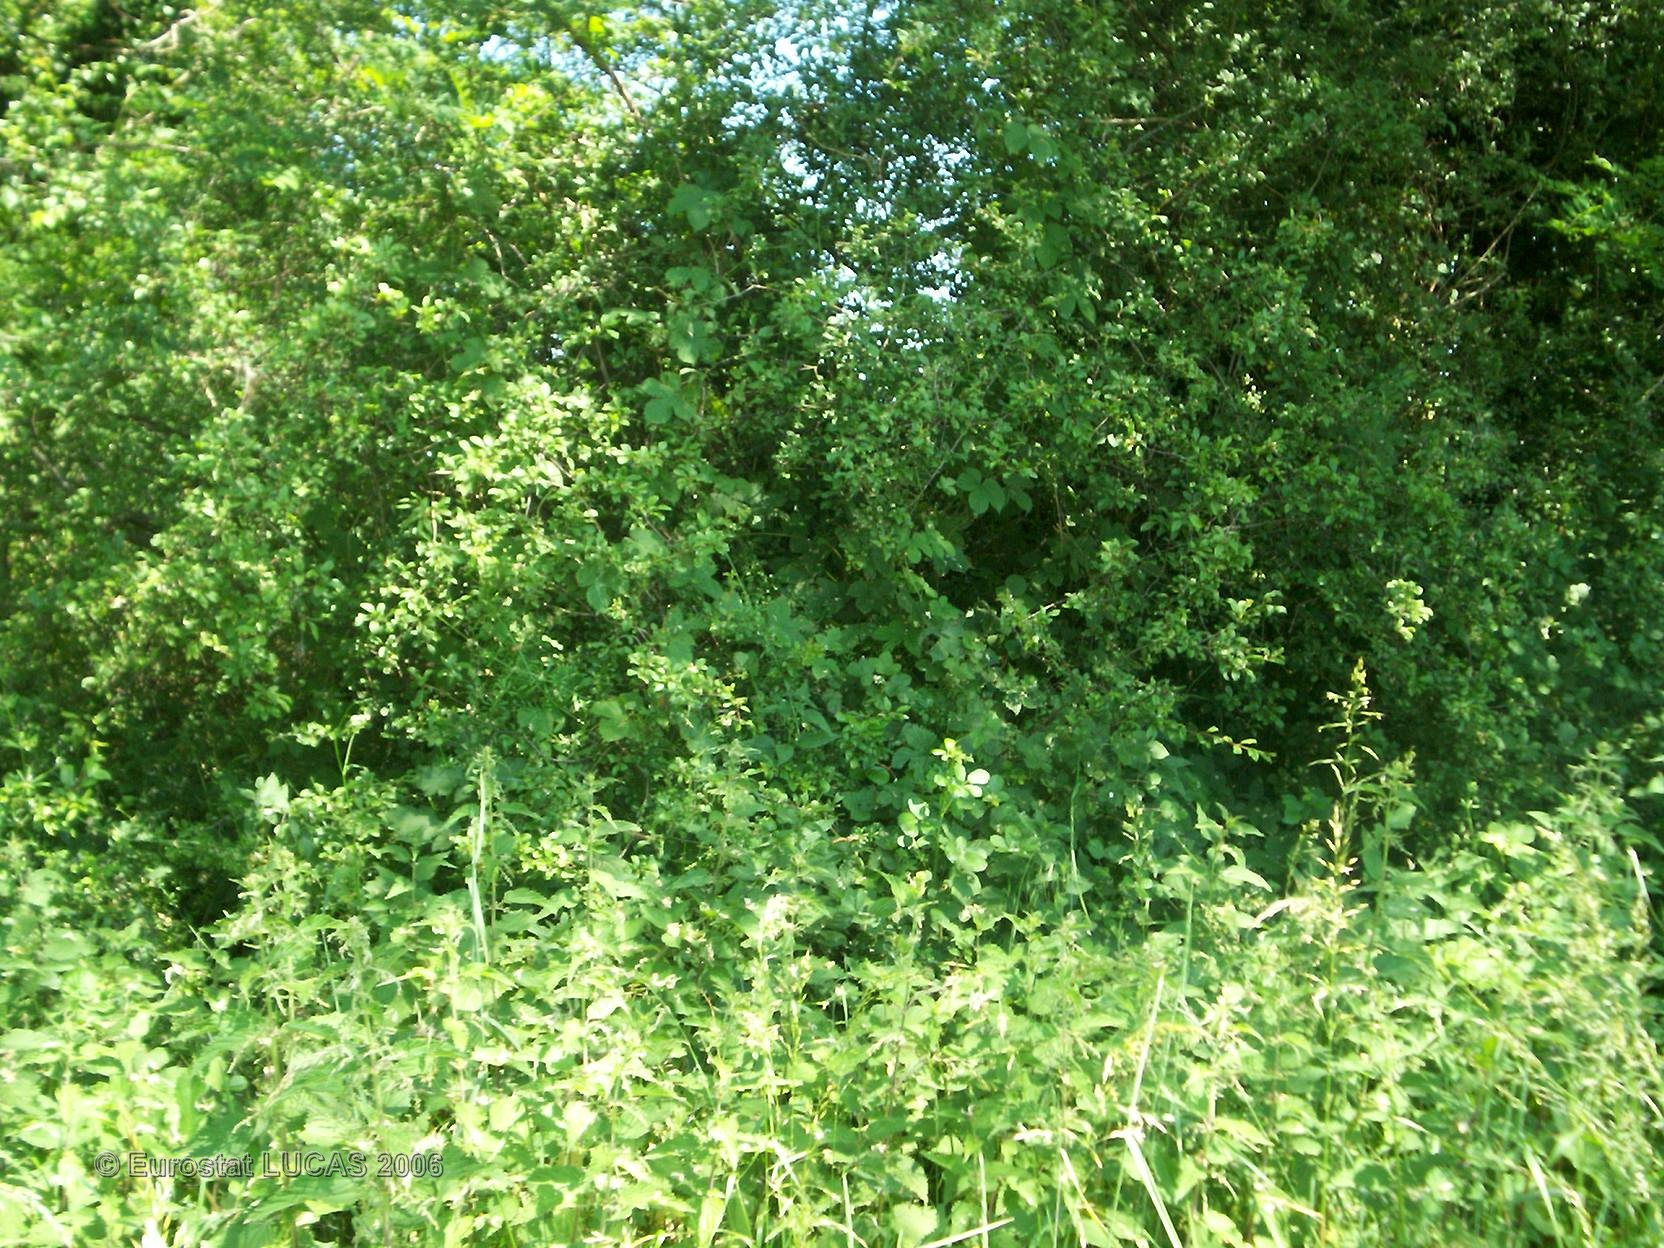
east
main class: Grassland
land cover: Grassland without tree/shrub cover
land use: Agriculture (excluding fallow land and kitchen gardens)
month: June
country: FR
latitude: 47.0115
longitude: 3.0638
